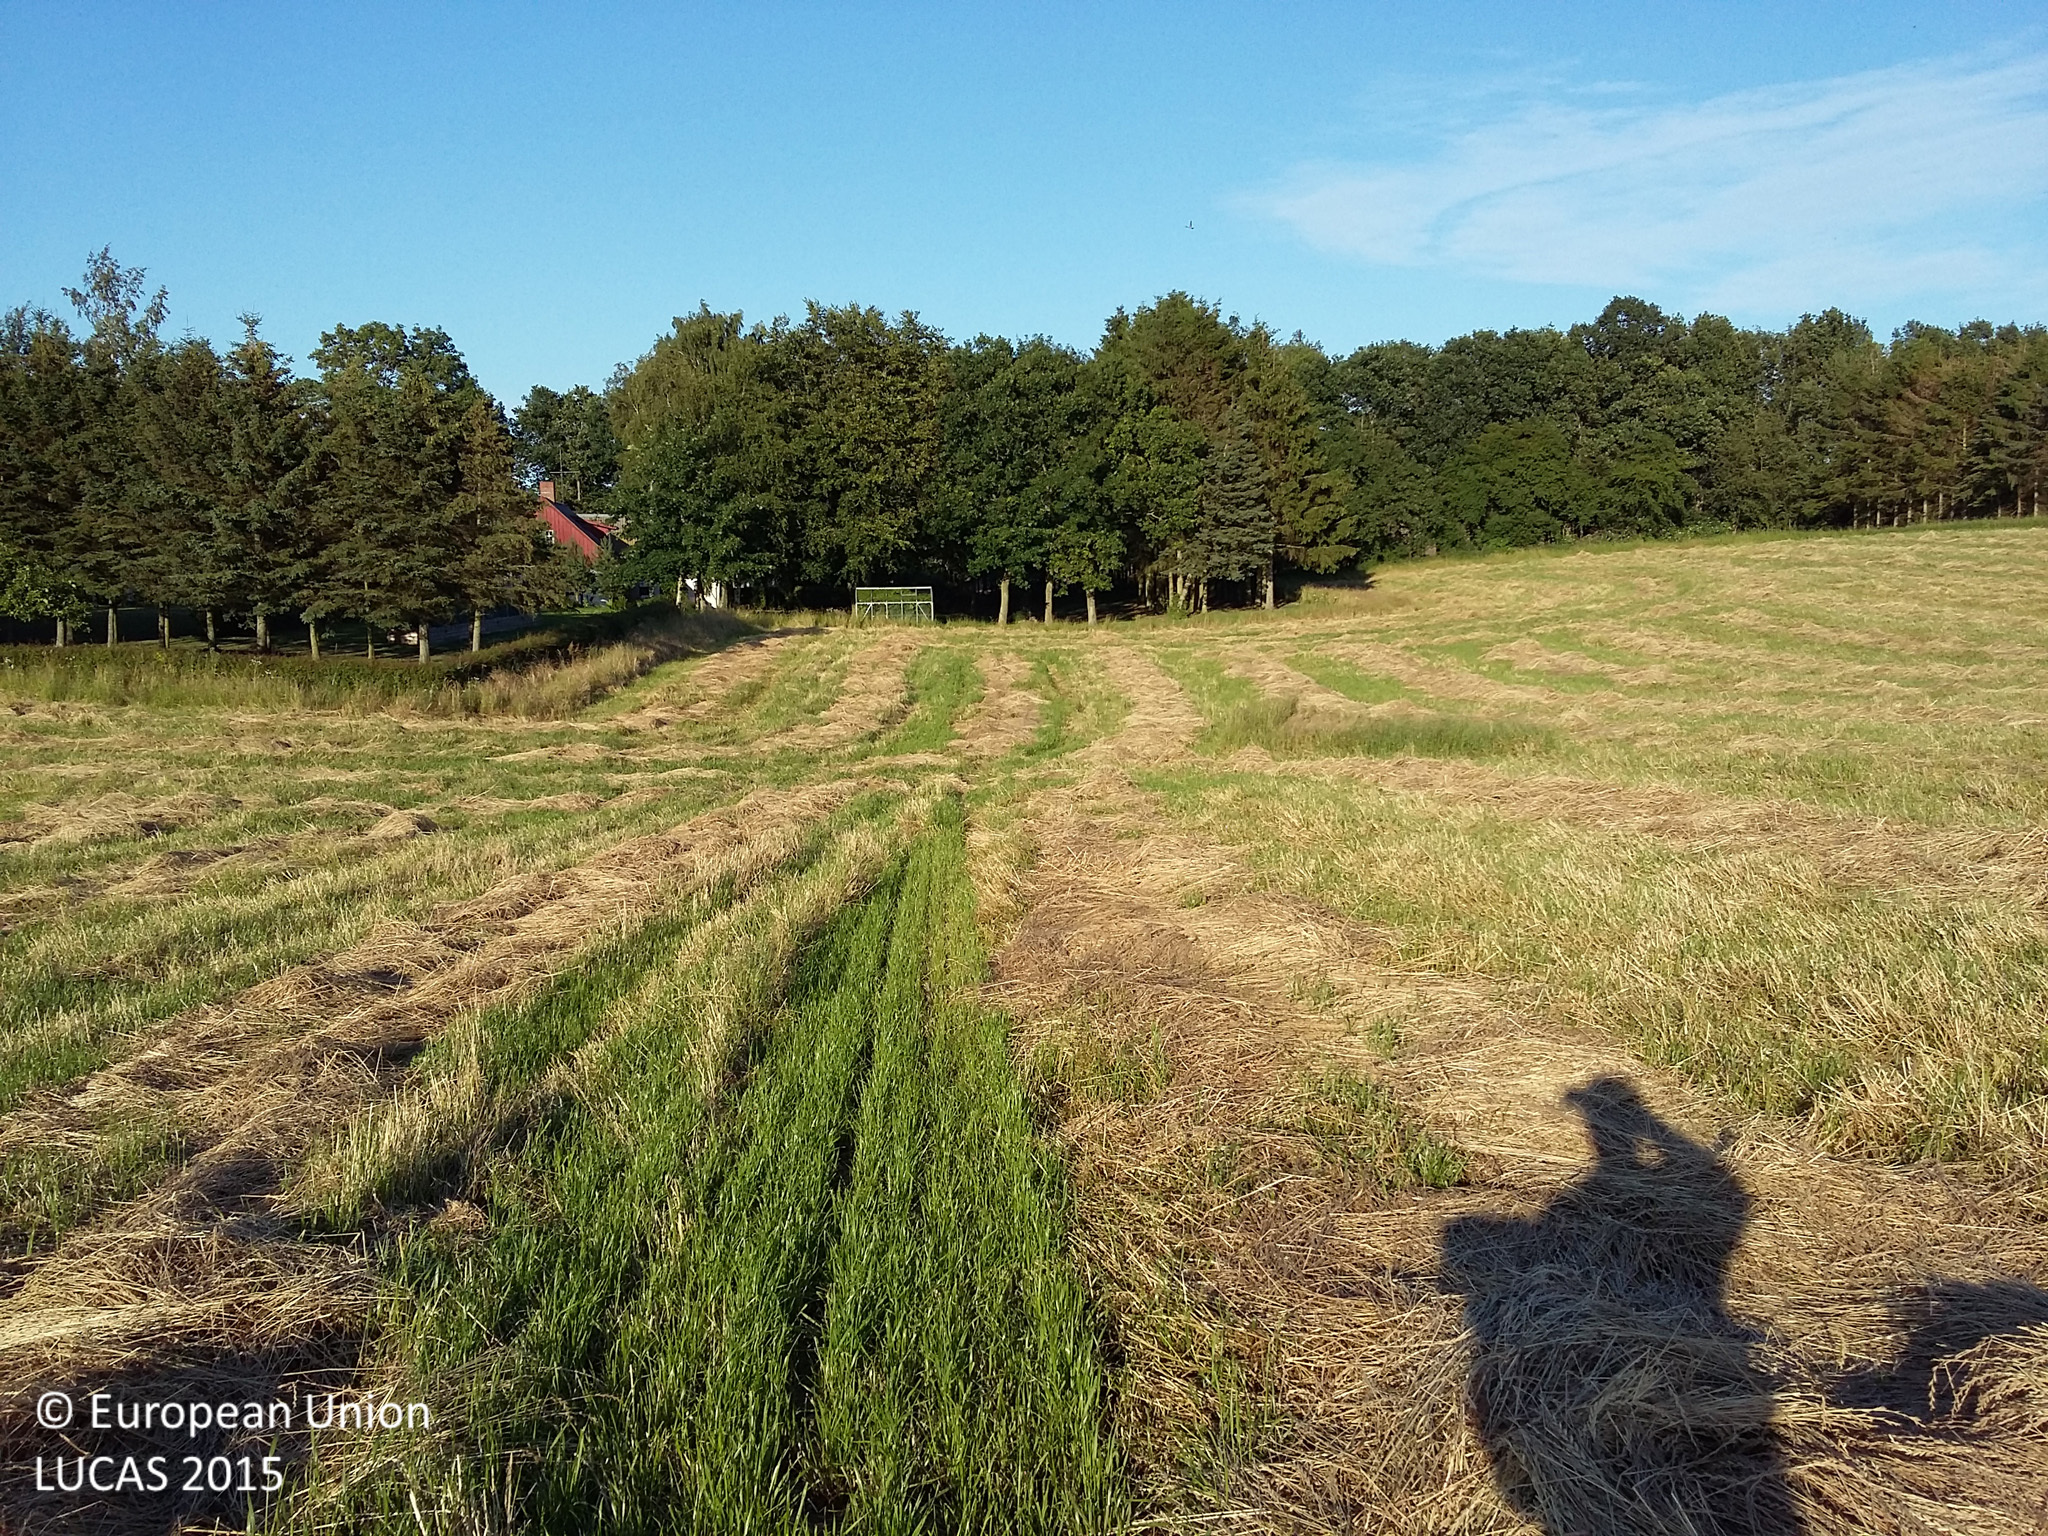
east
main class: Cropland
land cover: Temporary grasslands
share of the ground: > 75 %
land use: Agriculture (excluding fallow land and kitchen gardens)
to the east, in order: Temporary grasslands; Grass margins; Grassland without tree/shrub cover; Broadleaved woodland; Grassland without tree/shrub cover; Broadleaved woodland; Fences; Broadleaved woodland; Grassland without tree/shrub cover
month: July
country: DK
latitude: 55.6564
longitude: 11.6038
